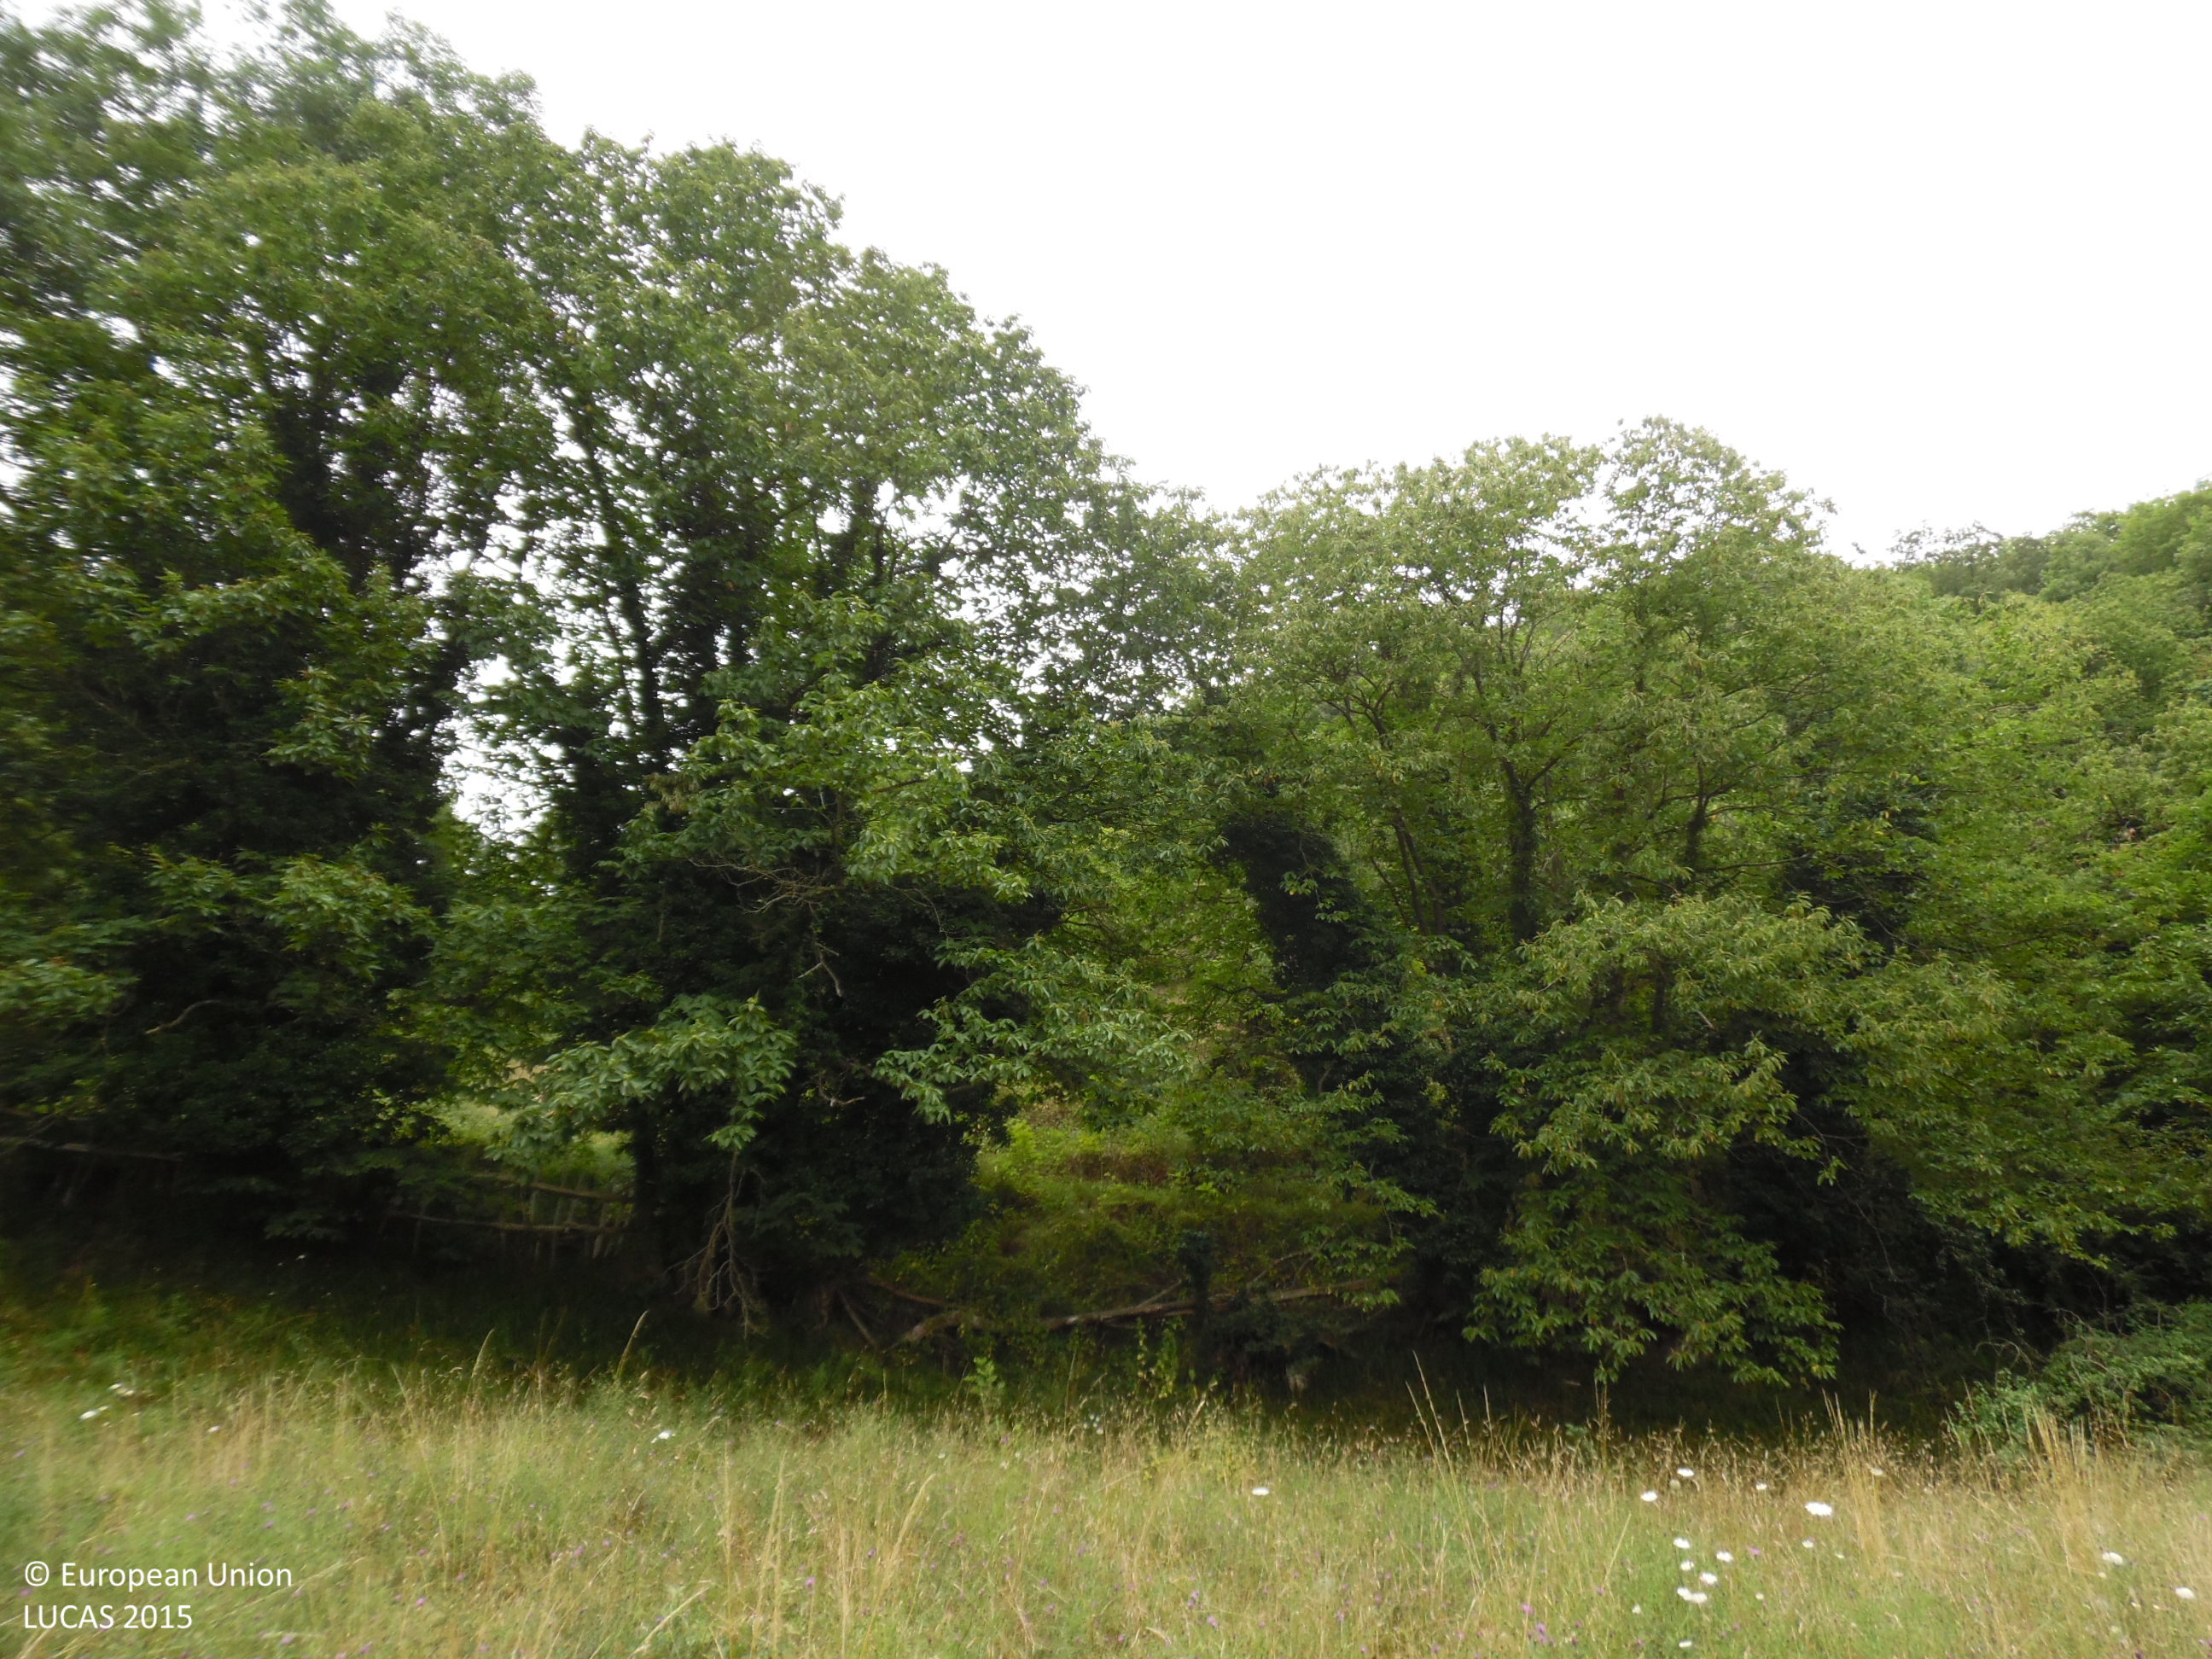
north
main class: Grassland
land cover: Grassland without tree/shrub cover
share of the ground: > 75 %
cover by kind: herbaceous plants 100 %
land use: Agriculture (excluding fallow land and kitchen gardens)
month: July
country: ES
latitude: 43.1599
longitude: -5.9656
